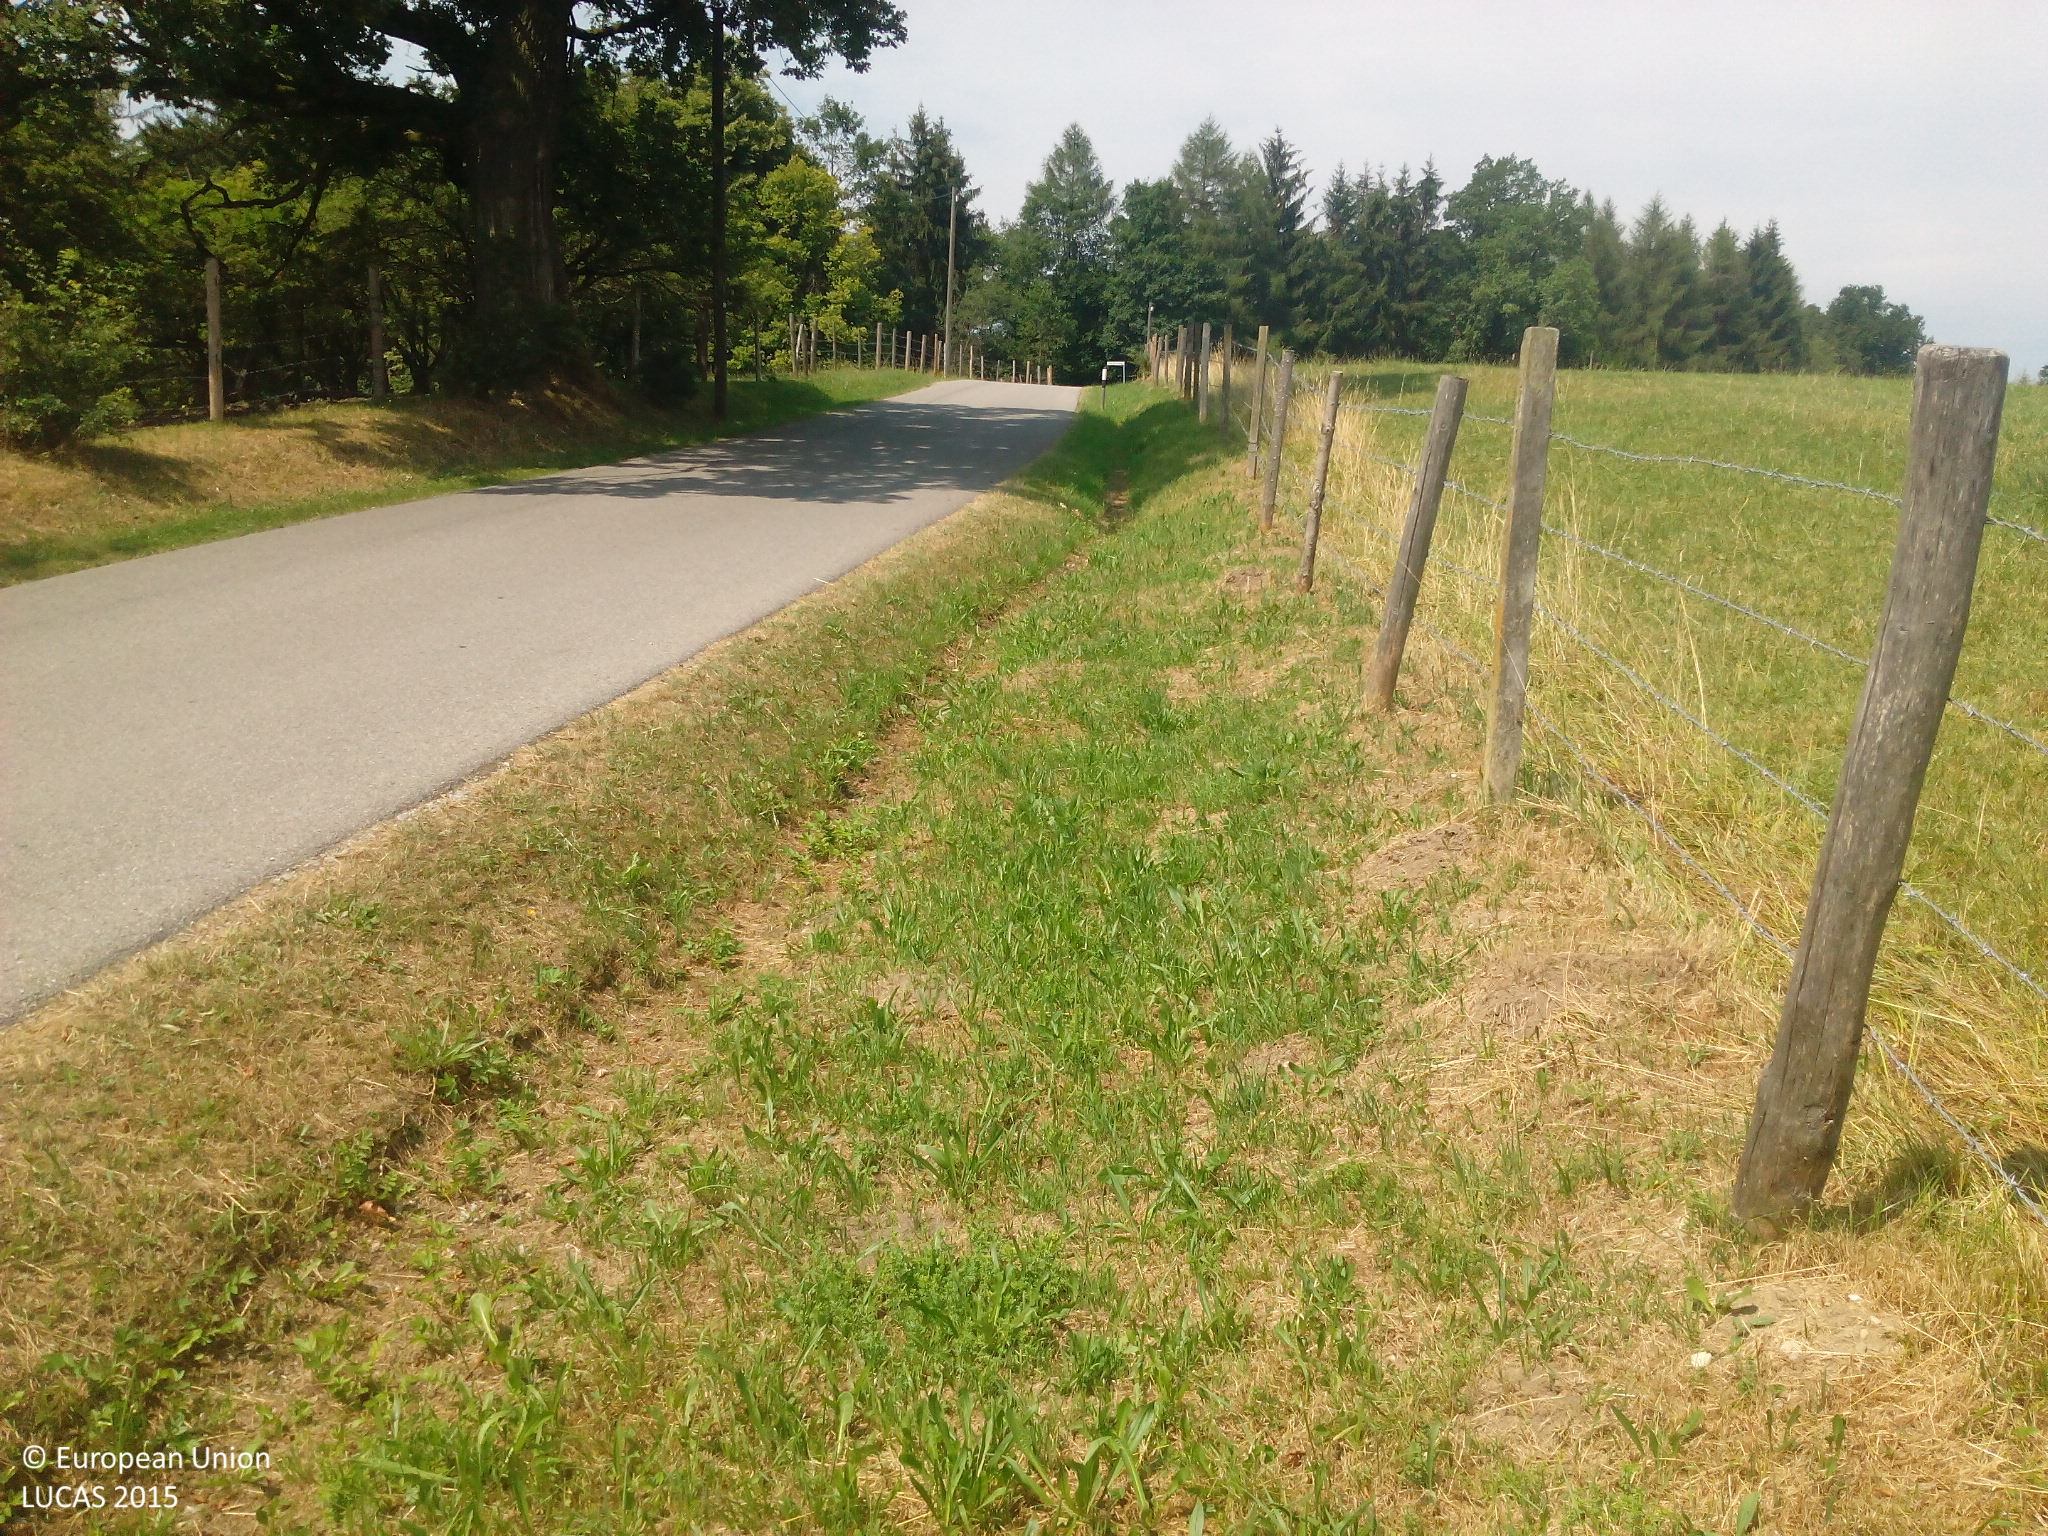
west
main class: Grassland
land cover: Grassland without tree/shrub cover
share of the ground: > 75 %
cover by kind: herbaceous plants 100 %
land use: Agriculture (excluding fallow land and kitchen gardens)
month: July
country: DE
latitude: 47.8235
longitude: 10.9477
